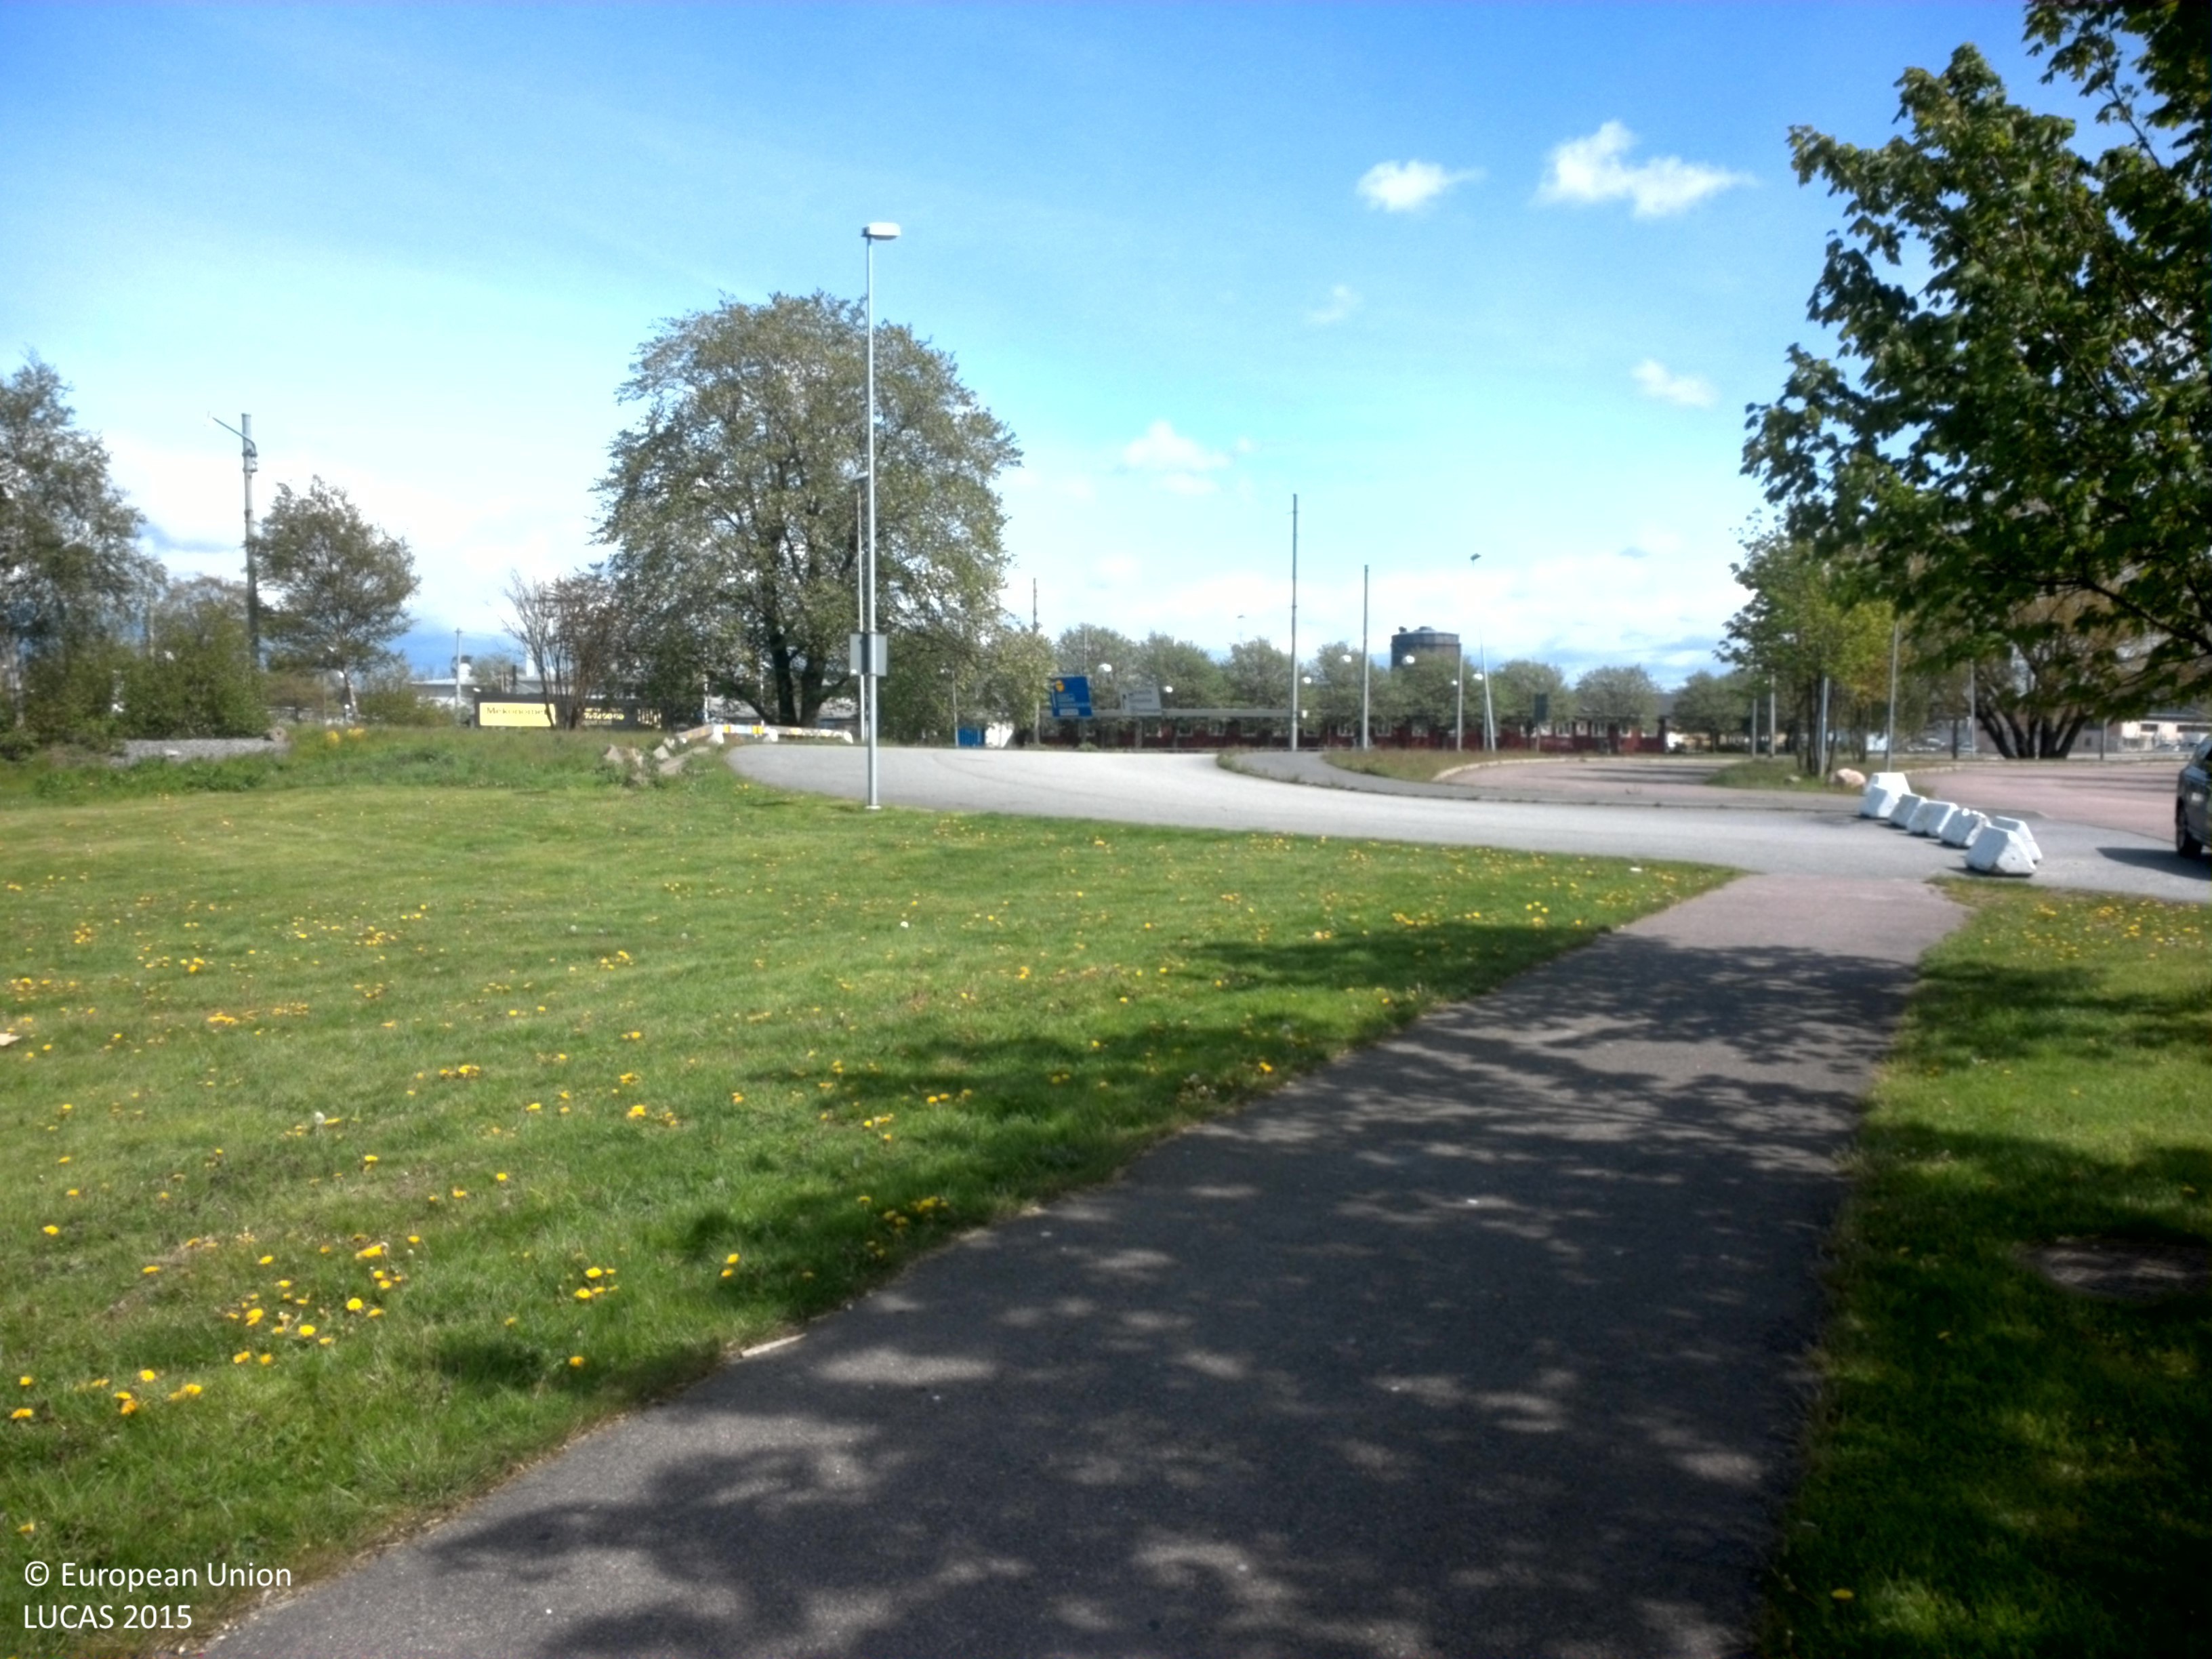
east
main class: Grassland
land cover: Grassland with sparse tree/shrub cover
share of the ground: > 75 %
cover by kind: herbaceous plants 95 %, broadleaved forest trees 5 %
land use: Road transport
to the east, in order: Grassland with sparse tree/shrub cover; Artificial constructions in urban areas
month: May
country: SE
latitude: 57.7195
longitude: 11.9609
